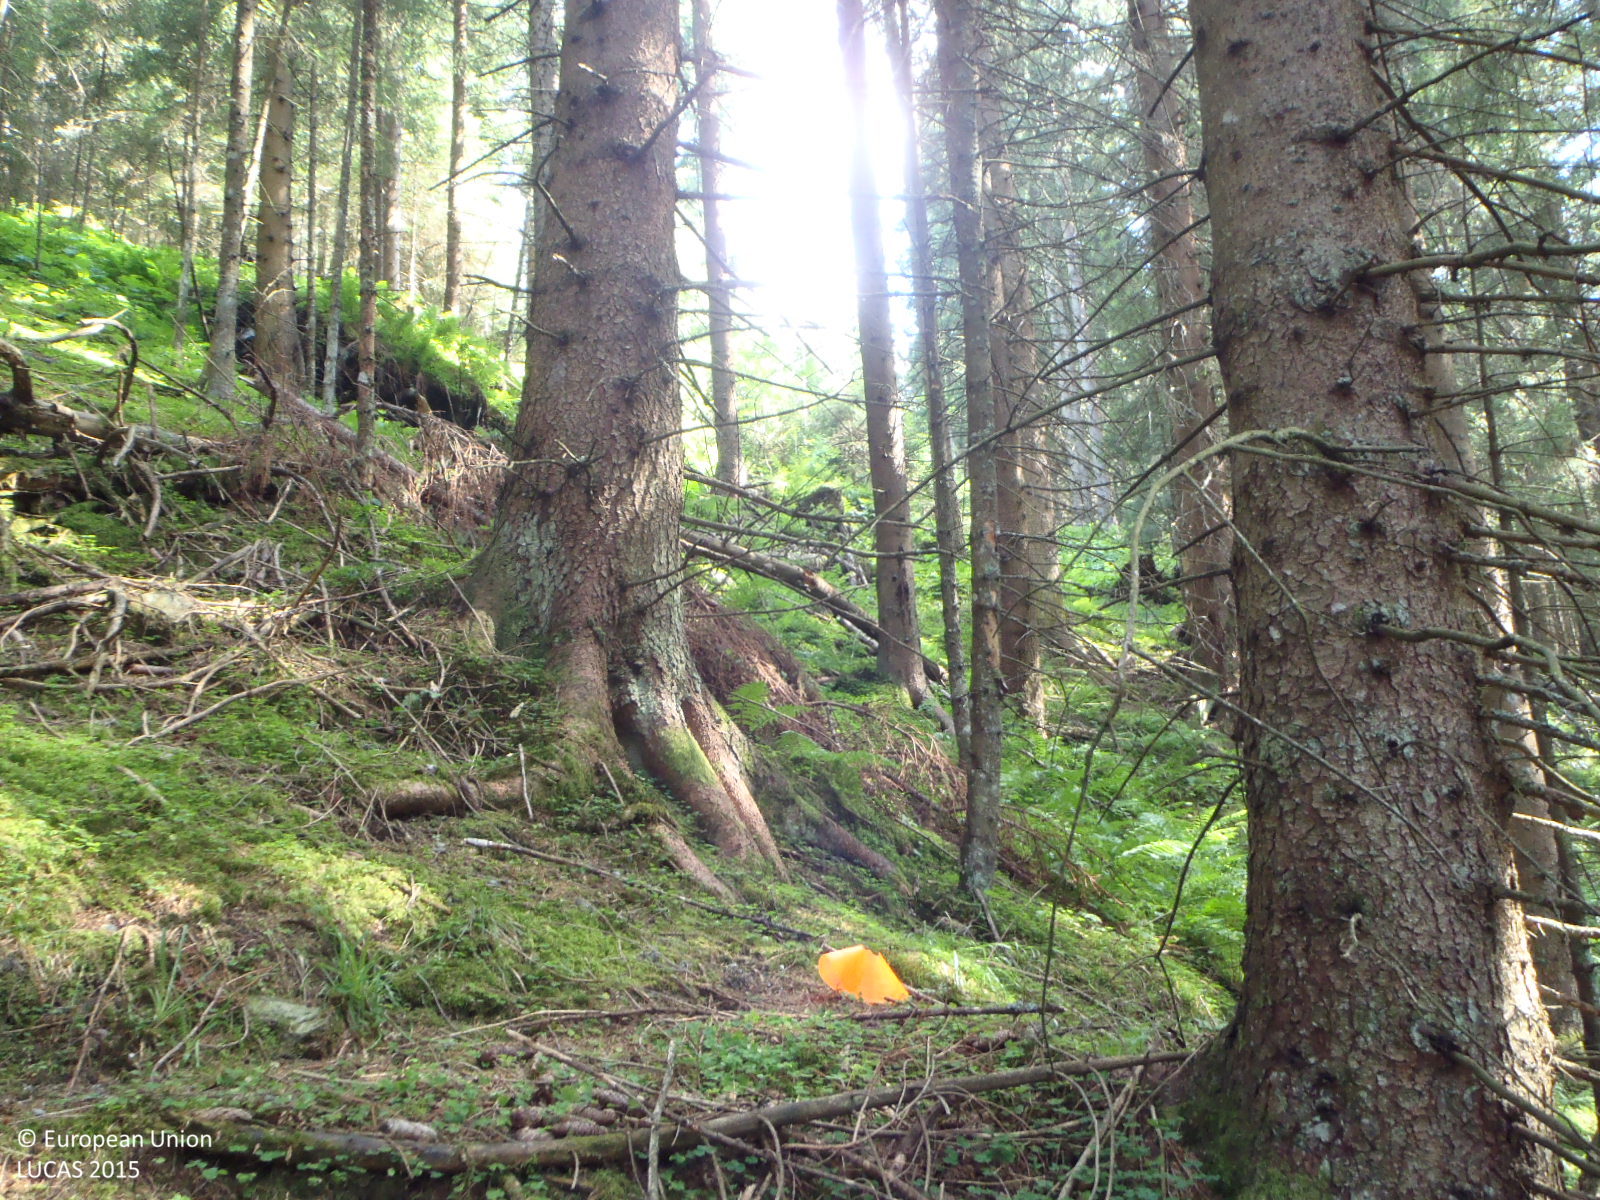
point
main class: Woodland
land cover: Spruce dominated coniferous woodland
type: alpine coniferous forest
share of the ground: > 75 %
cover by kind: coniferous forest trees 80 %, herbaceous plants 10 %, lichens and mosses 10 %
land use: Forestry
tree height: > 5 m
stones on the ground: < 10 %
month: July
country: AT
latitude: 47.3787
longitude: 11.9190
